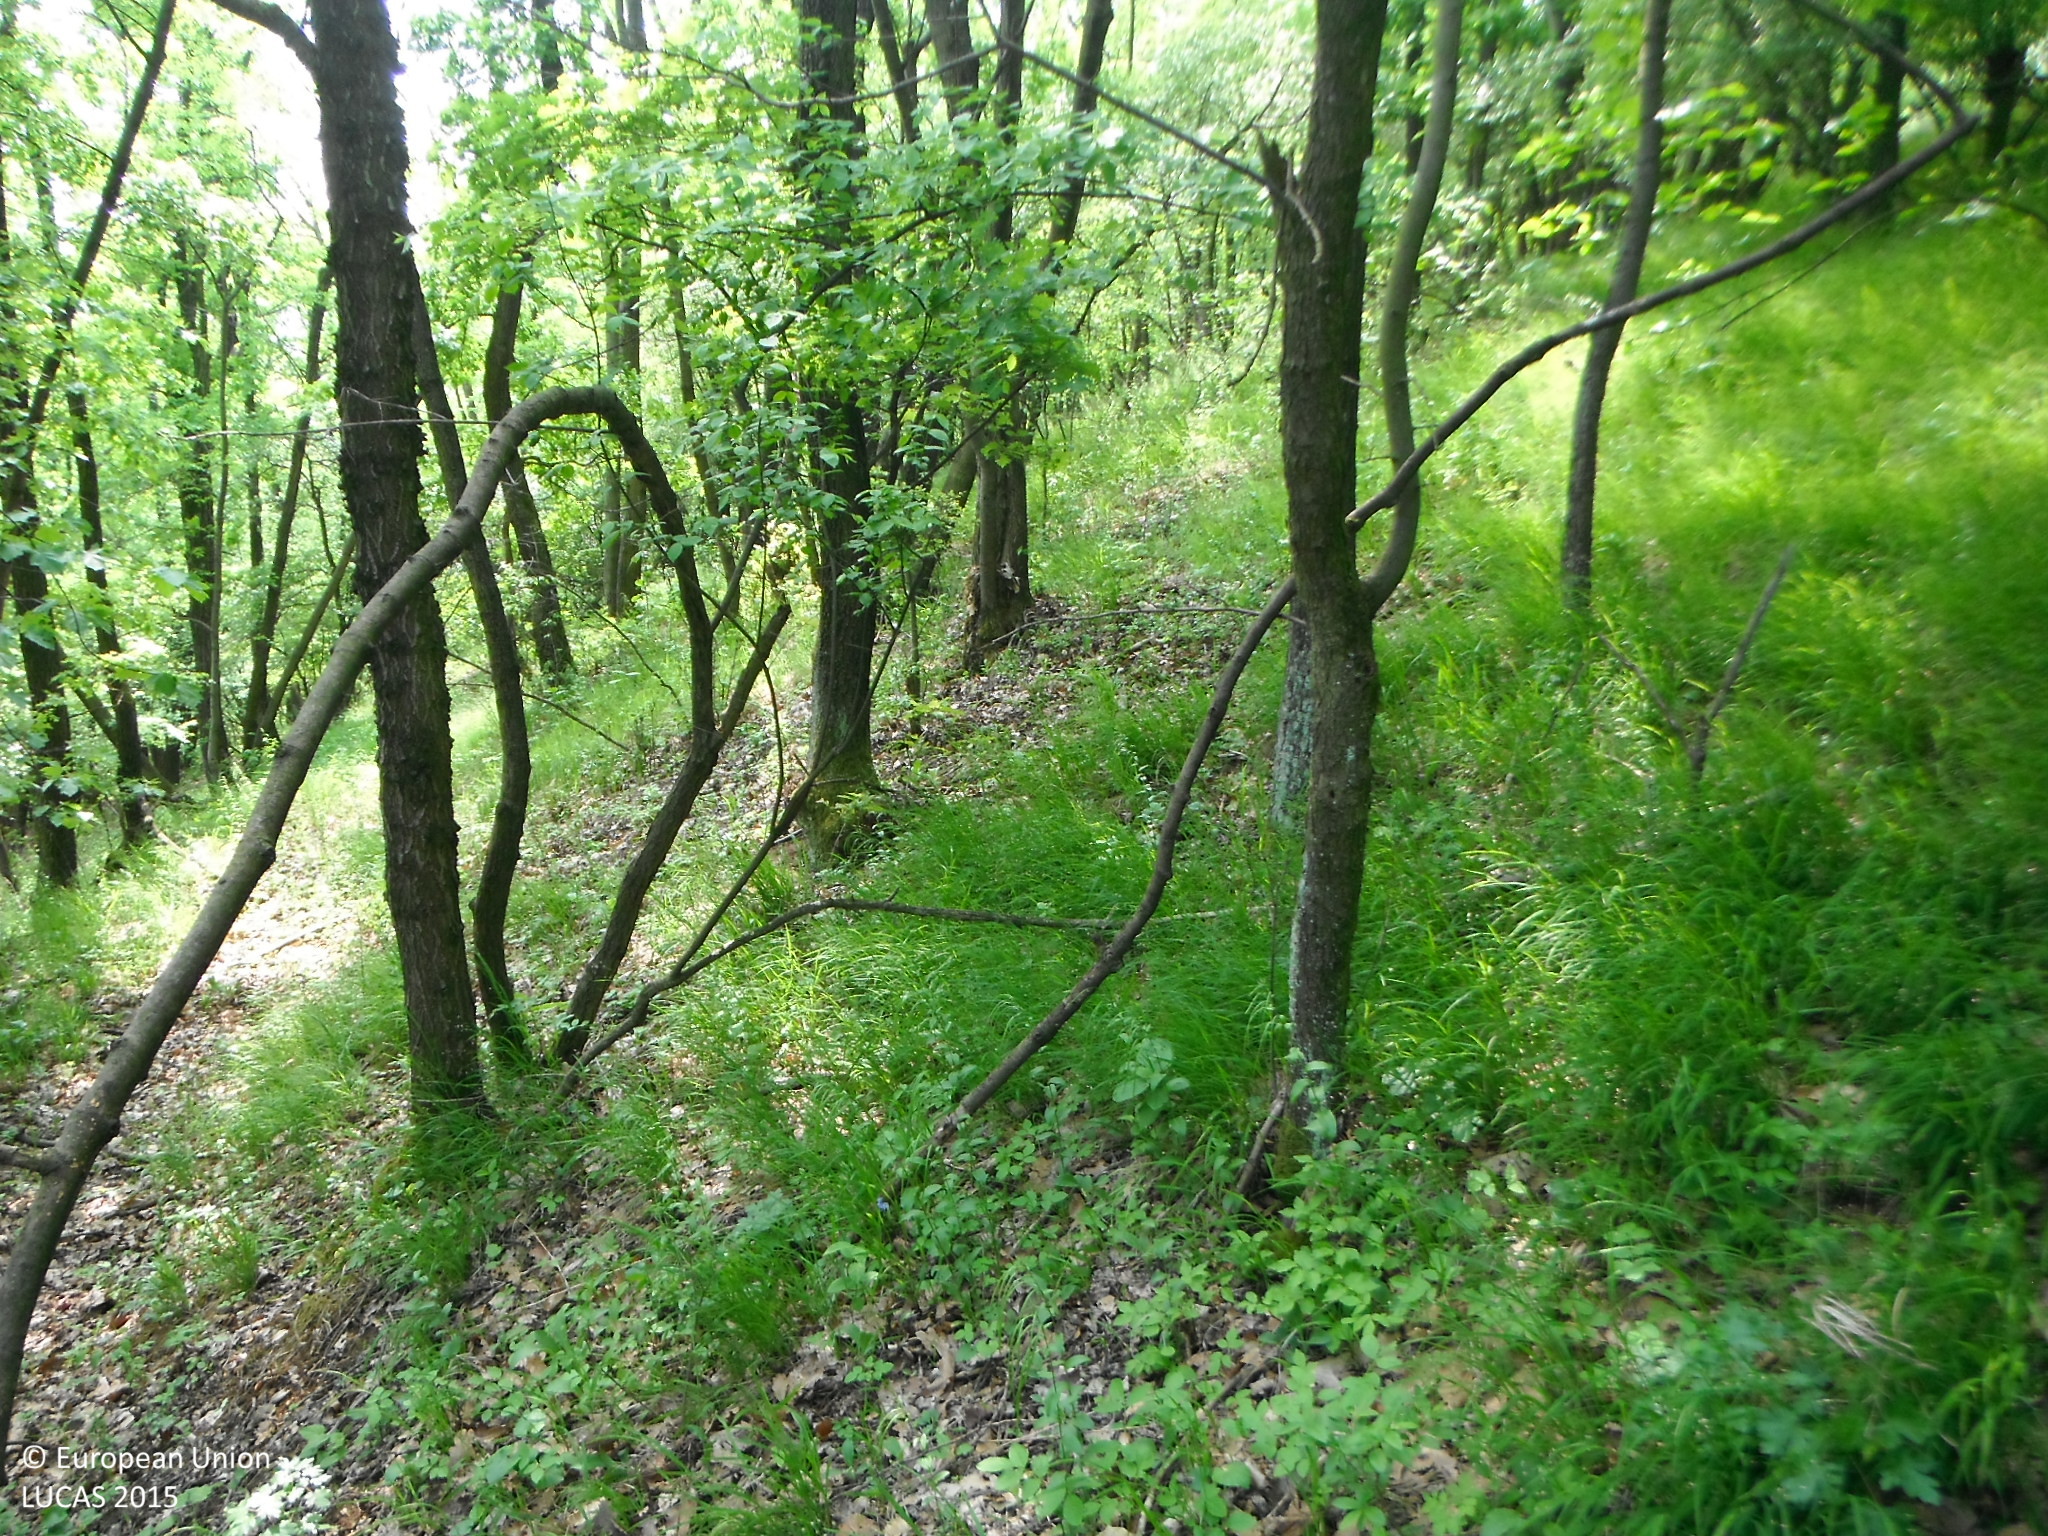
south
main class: Woodland
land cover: Broadleaved woodland
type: mesophytic deciduous forest
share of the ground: > 75 %
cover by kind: broadleaved forest trees 100 %
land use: Forestry
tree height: > 5 m
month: May
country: SK
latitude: 48.3593
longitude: 18.0982
